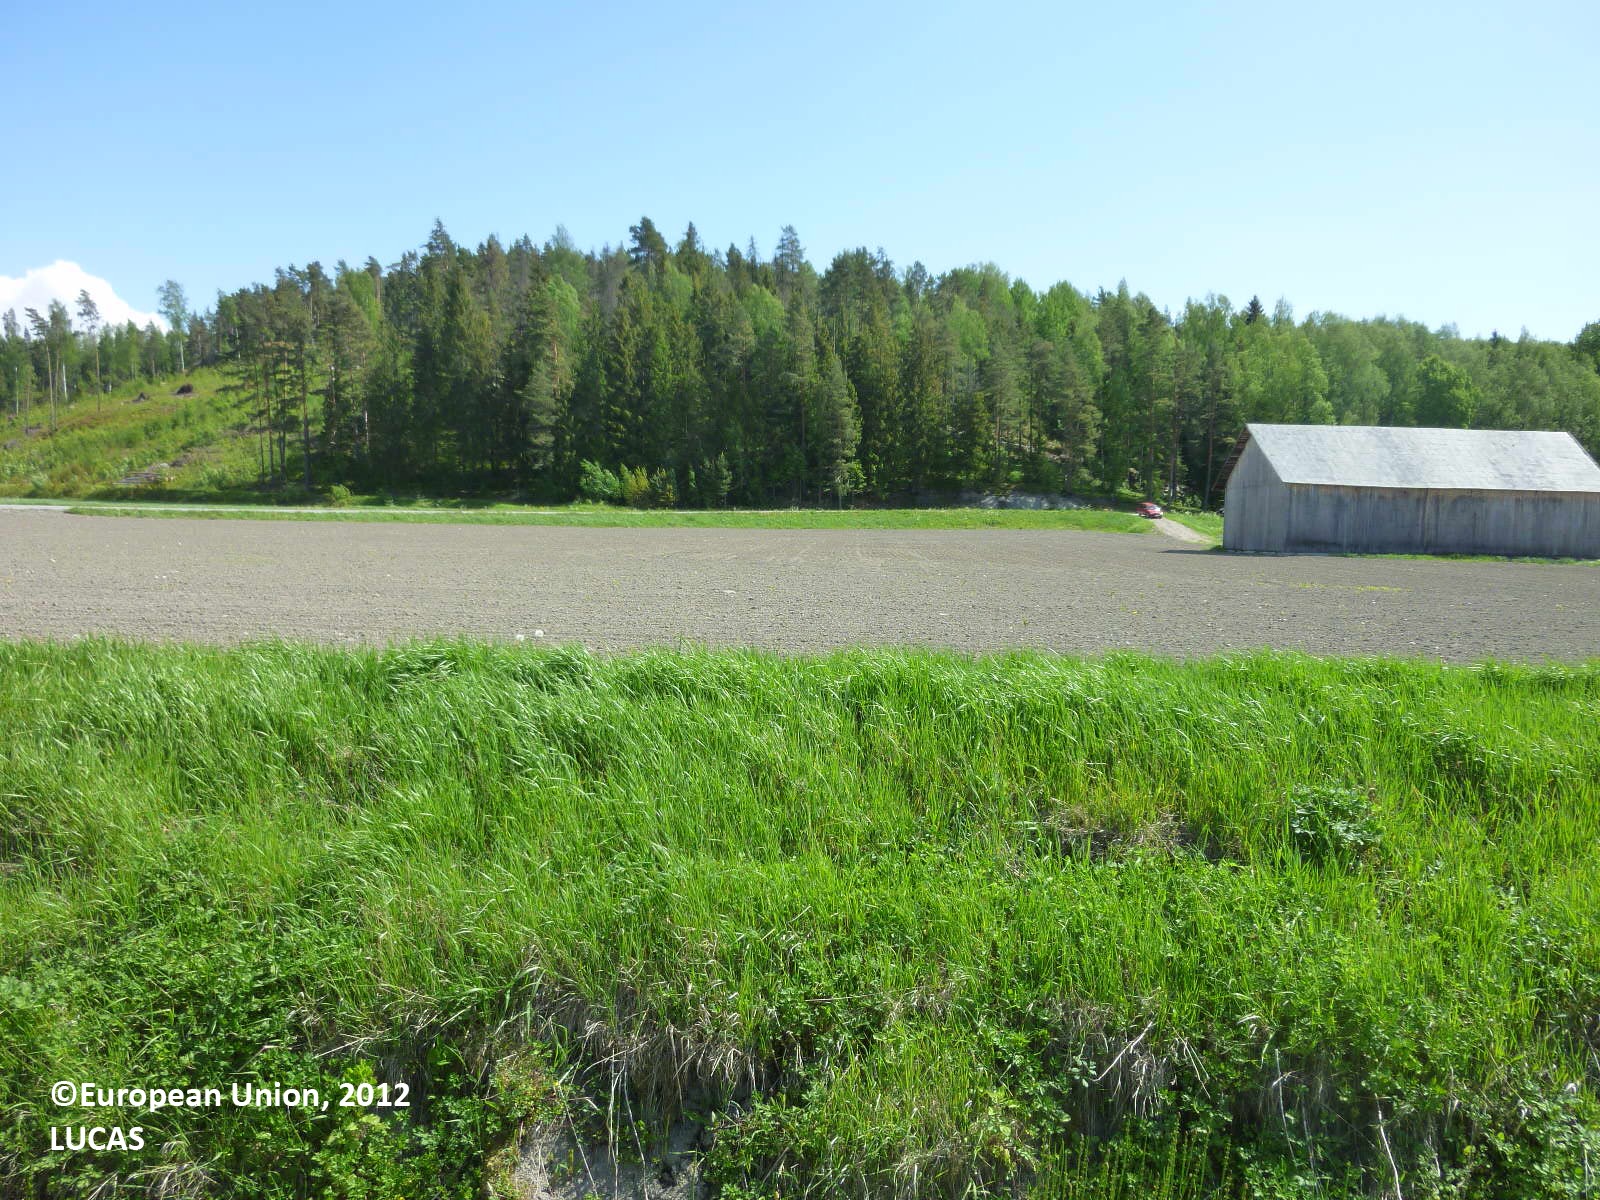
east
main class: Cropland
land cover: Temporary grasslands
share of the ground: > 75 %
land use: Agriculture (excluding fallow land and kitchen gardens)
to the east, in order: Temporary grasslands; Grass margins; Ditches and canals; Grass margins; Other bare soil; Grass margins; Ditches and canals; Grass margins; Paved roads, cycling and walking lanes; Shrubland without tree cover; Common wheat; Shrubland without tree cover
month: June
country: FI
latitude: 60.3890
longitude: 22.4992
